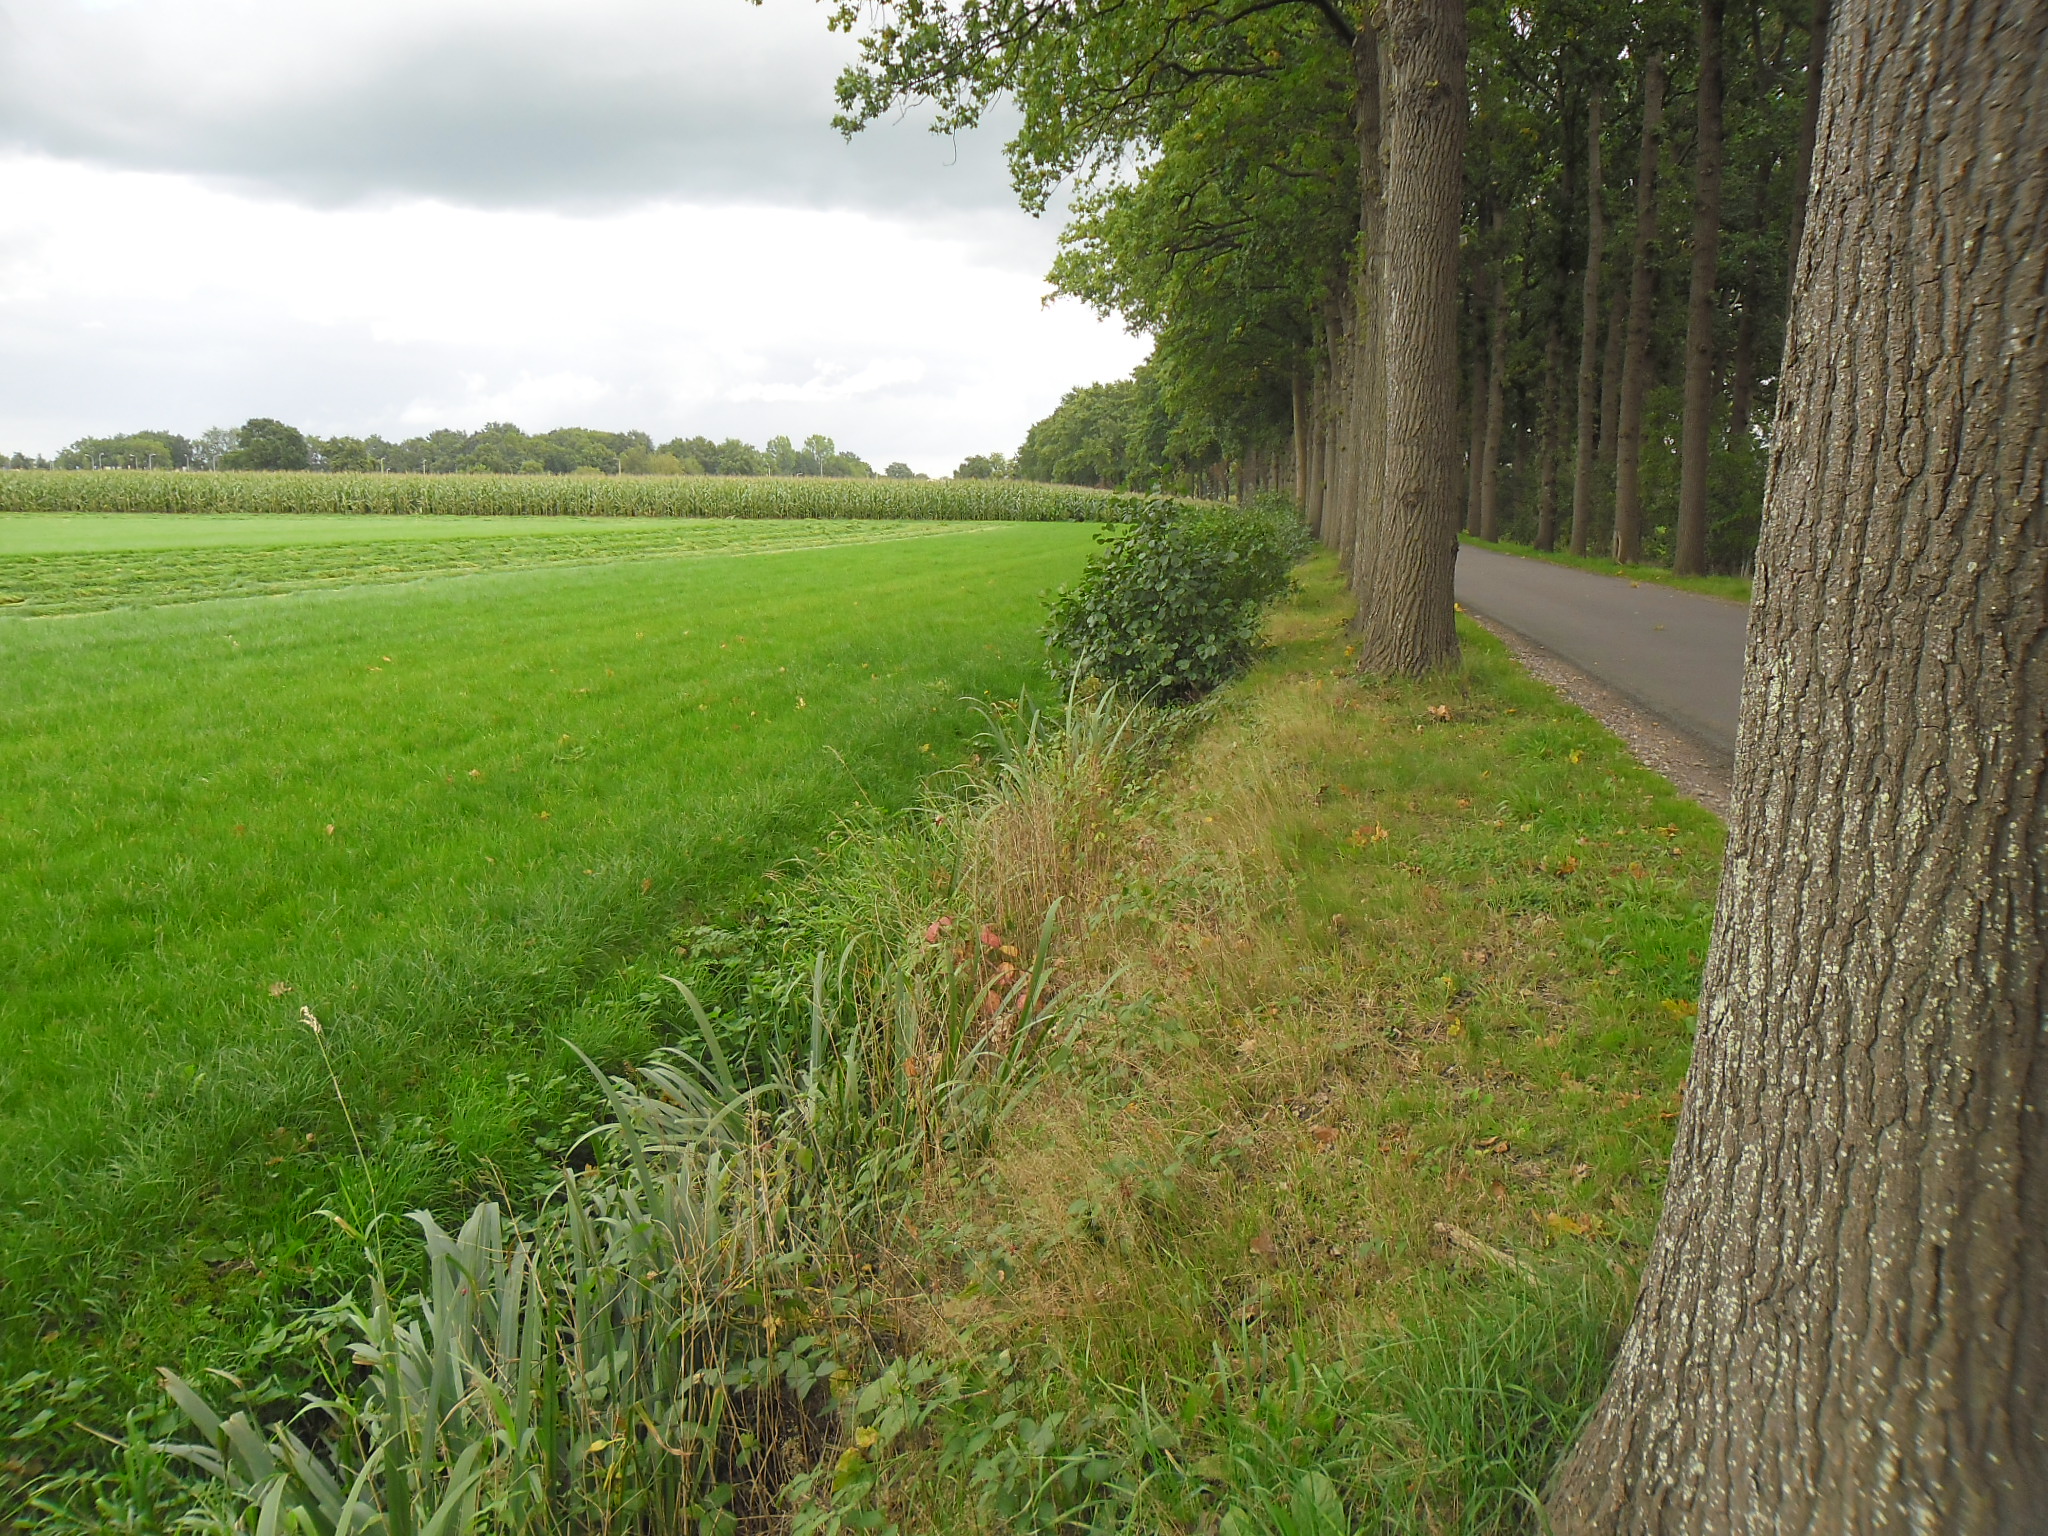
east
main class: Grassland
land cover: Grassland without tree/shrub cover
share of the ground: > 75 %
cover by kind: herbaceous plants 100 %
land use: Agriculture (excluding fallow land and kitchen gardens)
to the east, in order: Grassland without tree/shrub cover
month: September
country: NL
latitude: 52.1643
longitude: 5.4516
